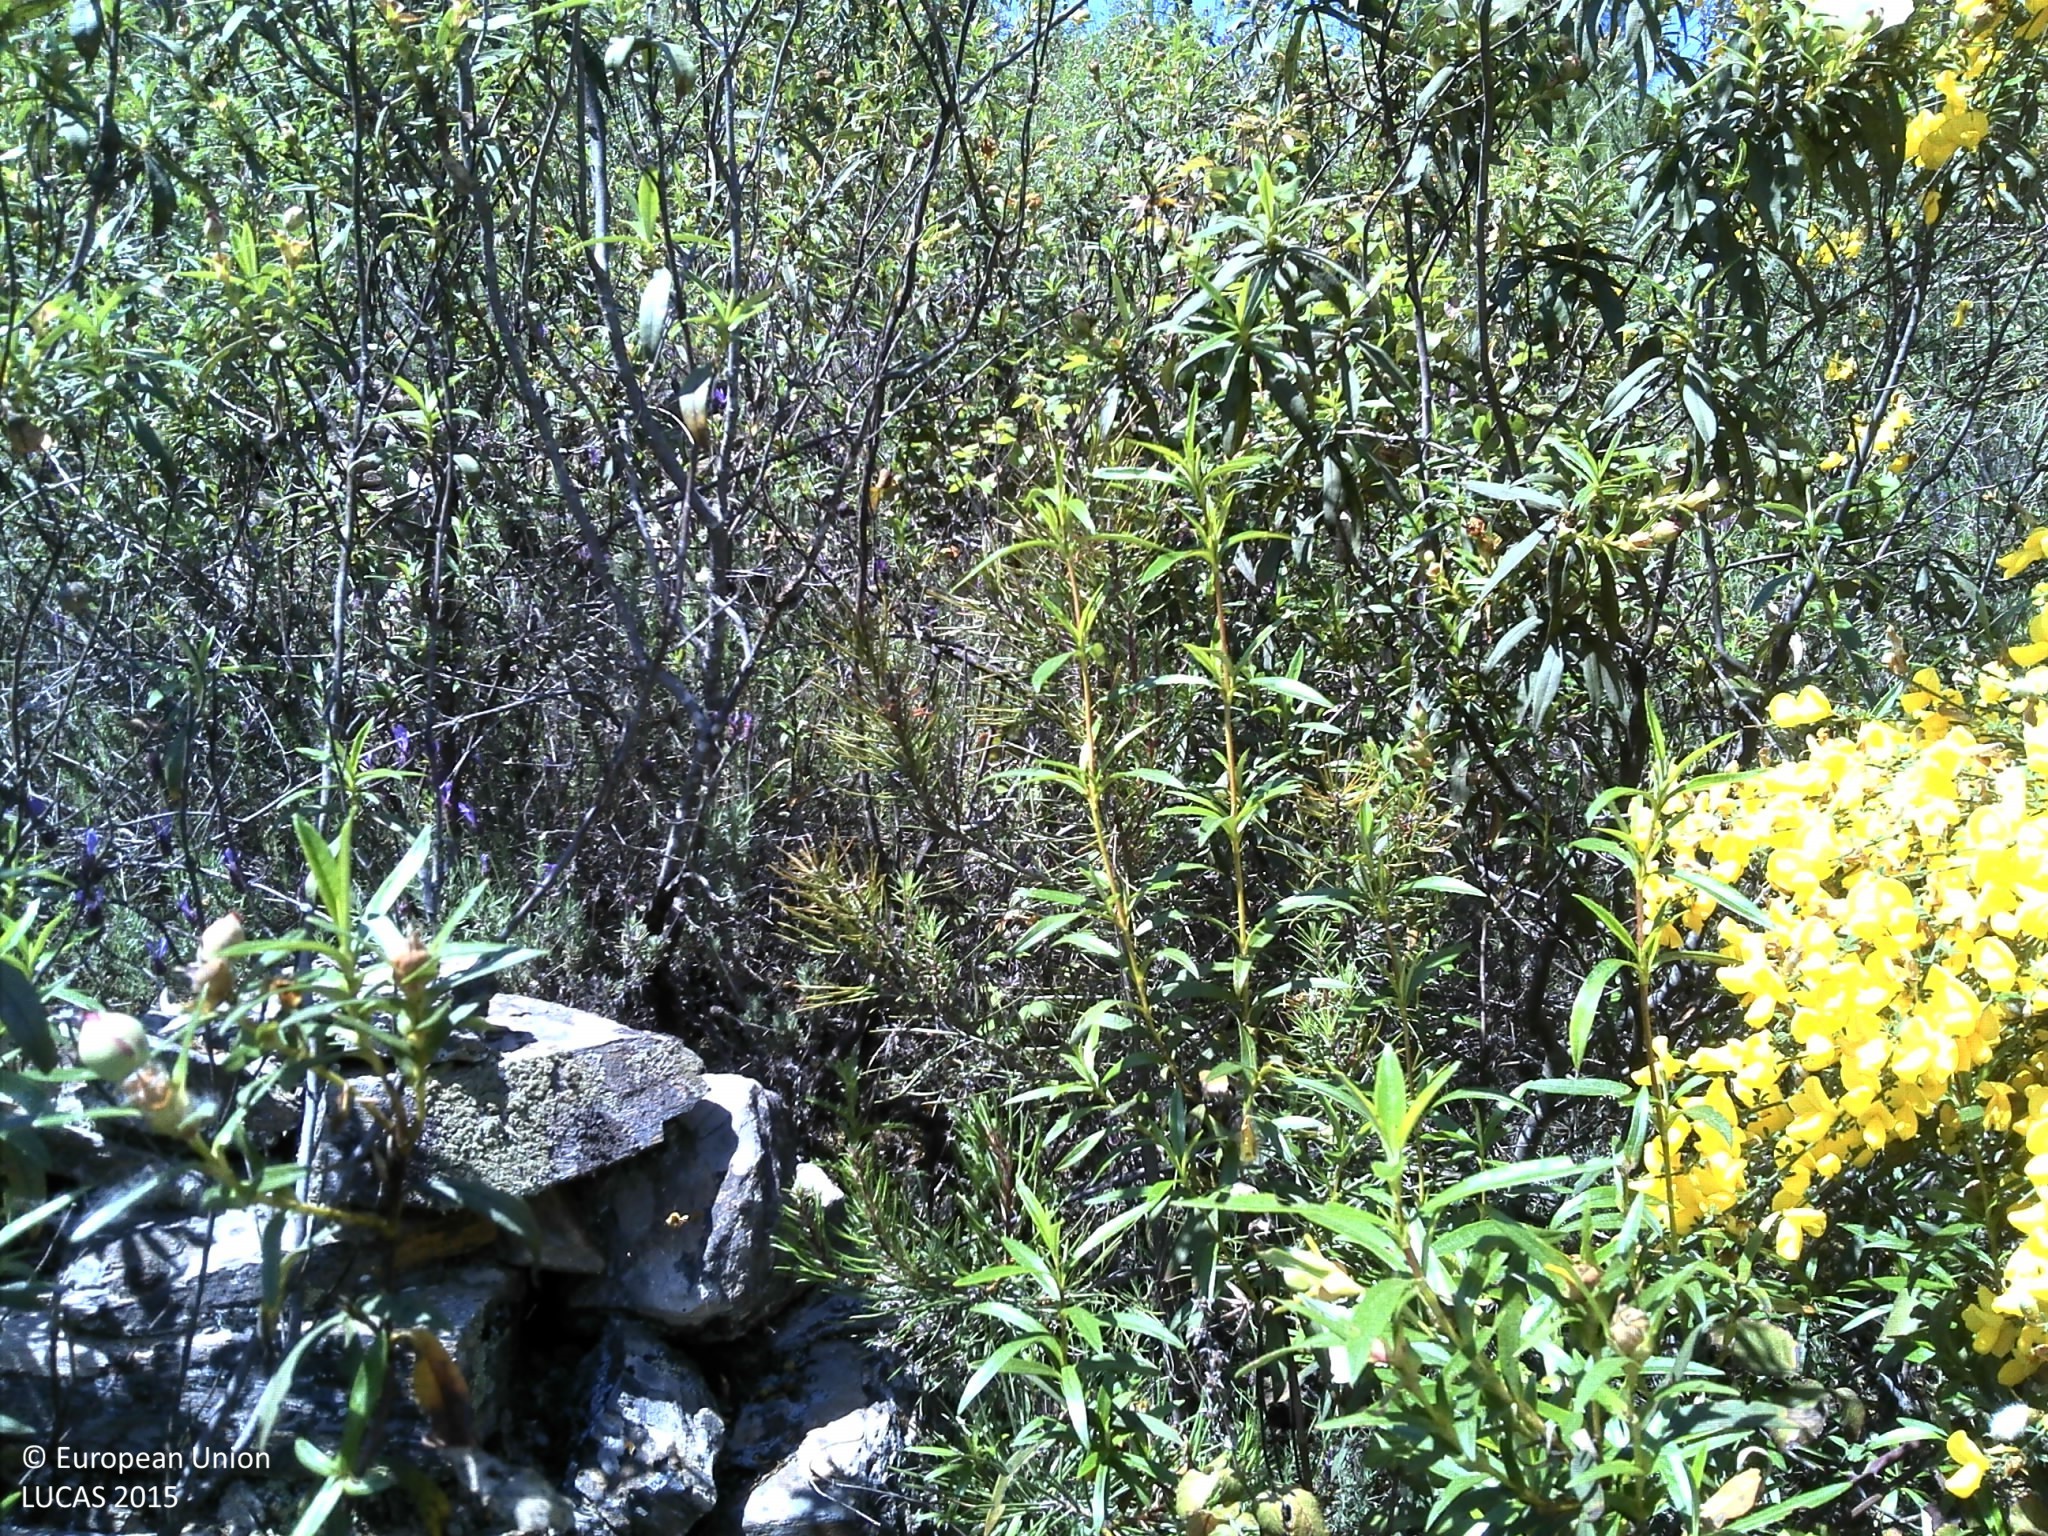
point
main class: Shrubland
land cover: Shrubland with sparse tree cover
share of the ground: > 75 %
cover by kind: shrubs 90 %, coniferous forest trees 5 %, unconsolidated bare surface 5 %
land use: Forestry
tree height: > 5 m
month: May
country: PT
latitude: 41.7380
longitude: -7.1102
